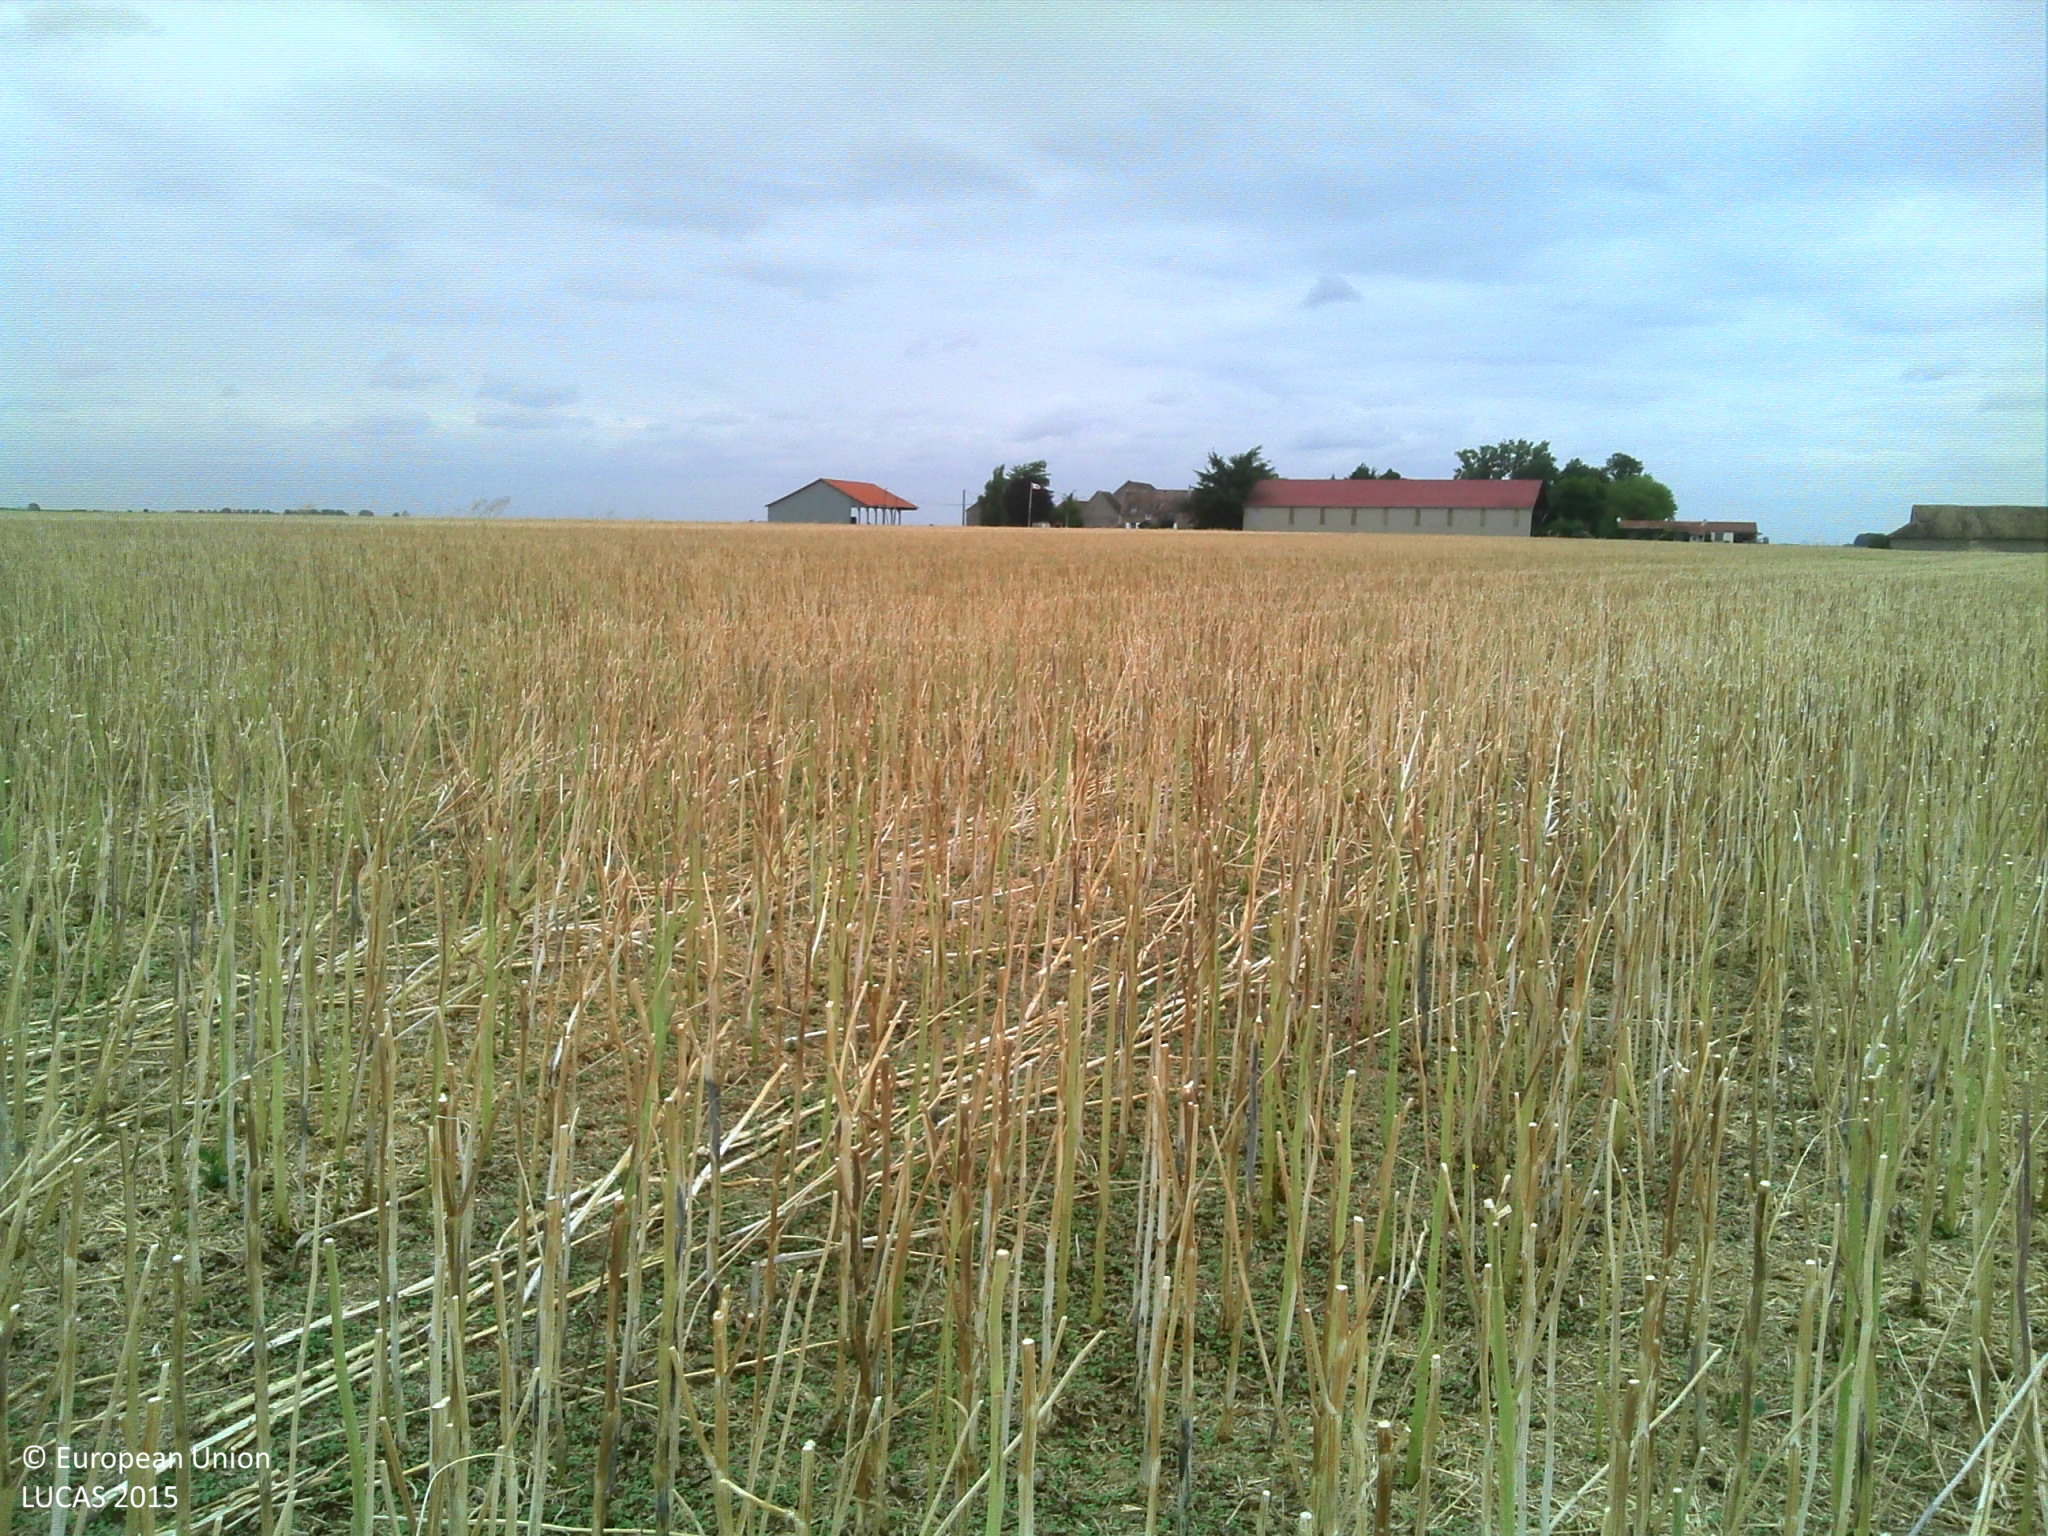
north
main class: Cropland
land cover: Rape and turnip rape
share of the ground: > 75 %
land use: Agriculture (excluding fallow land and kitchen gardens)
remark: Harvested field
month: July
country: FR
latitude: 48.5962
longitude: 2.7089
